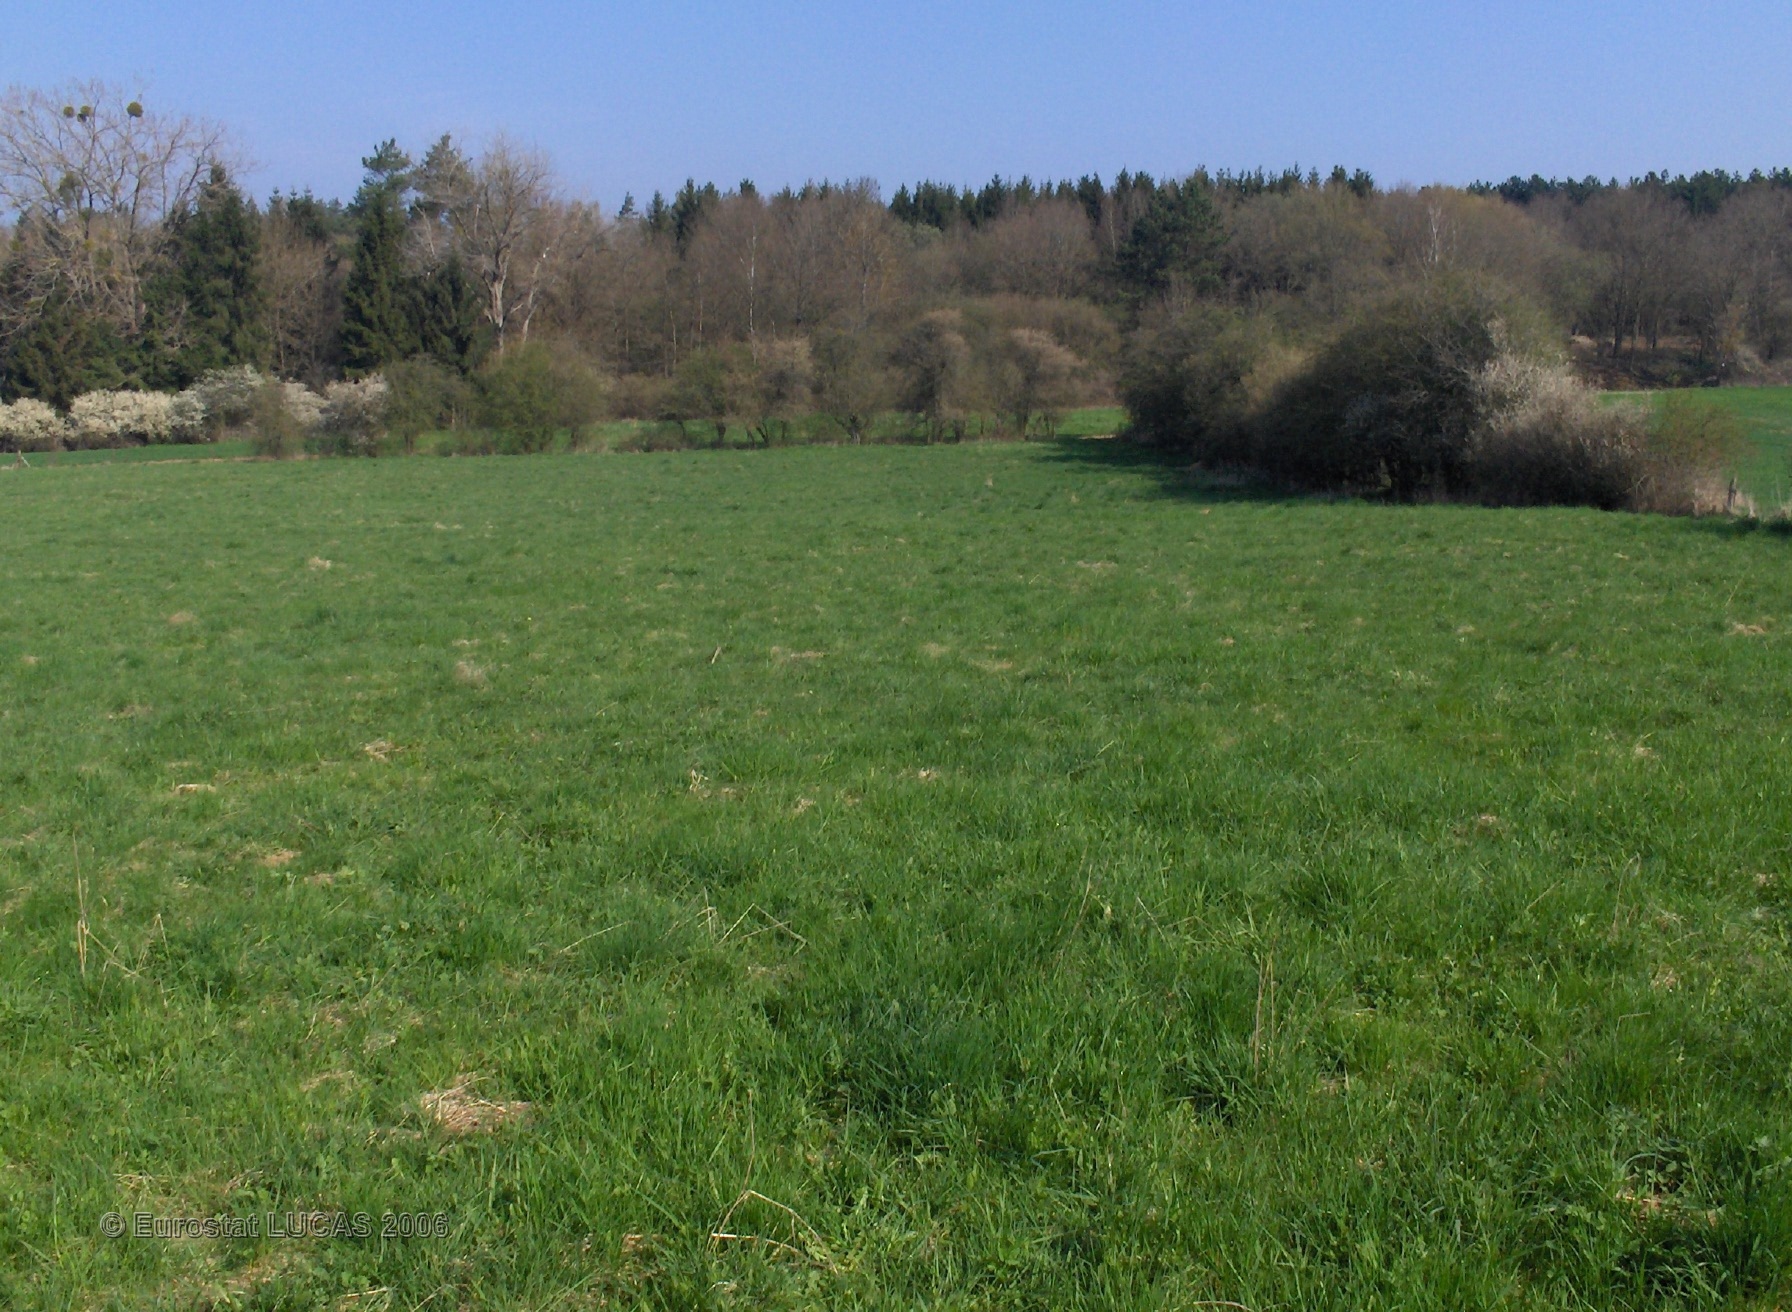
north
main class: Grassland
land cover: Grassland without tree/shrub cover
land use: Agriculture (excluding fallow land and kitchen gardens)
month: April
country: BE
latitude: 50.0725
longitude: 4.5610
